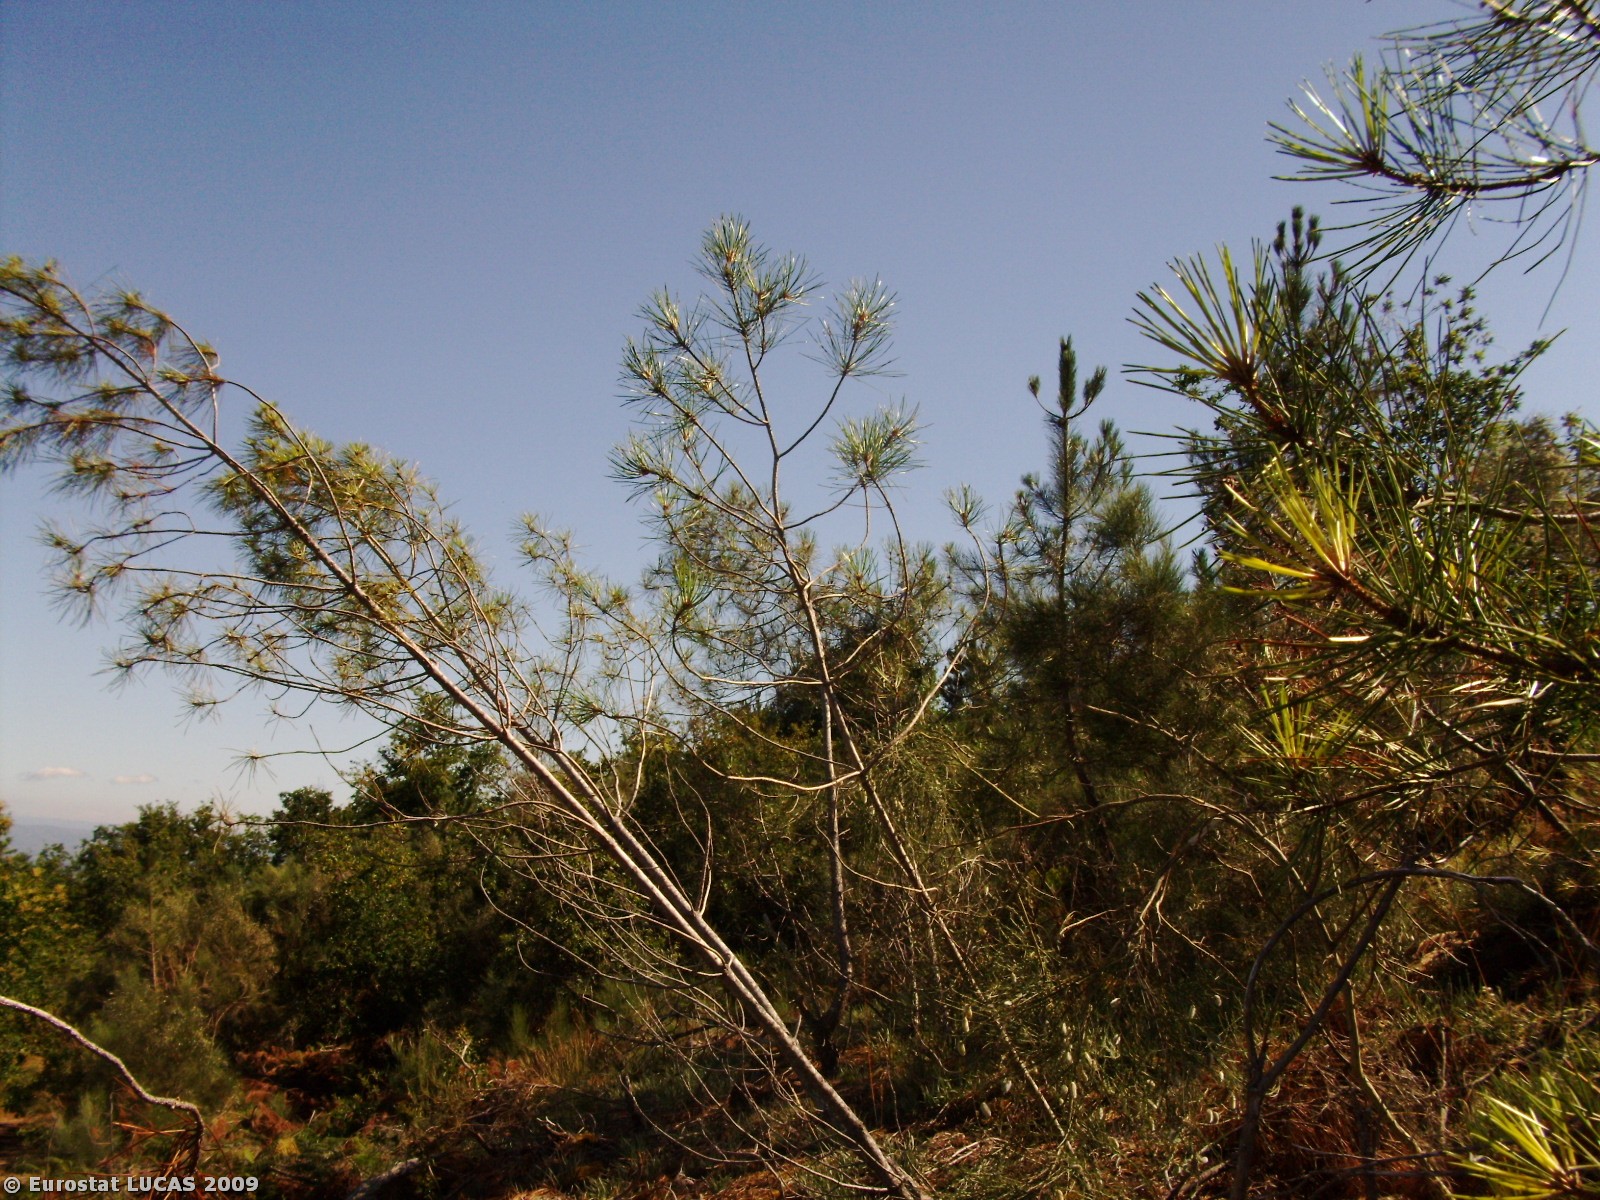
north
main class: Woodland
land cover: Coniferous woodland
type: coniferous forest of the mediterranean region
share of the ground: 10 - 25 %
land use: Forestry
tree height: > 5 m
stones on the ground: < 10 %
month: June
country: PT
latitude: 40.3968
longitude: -7.7046
